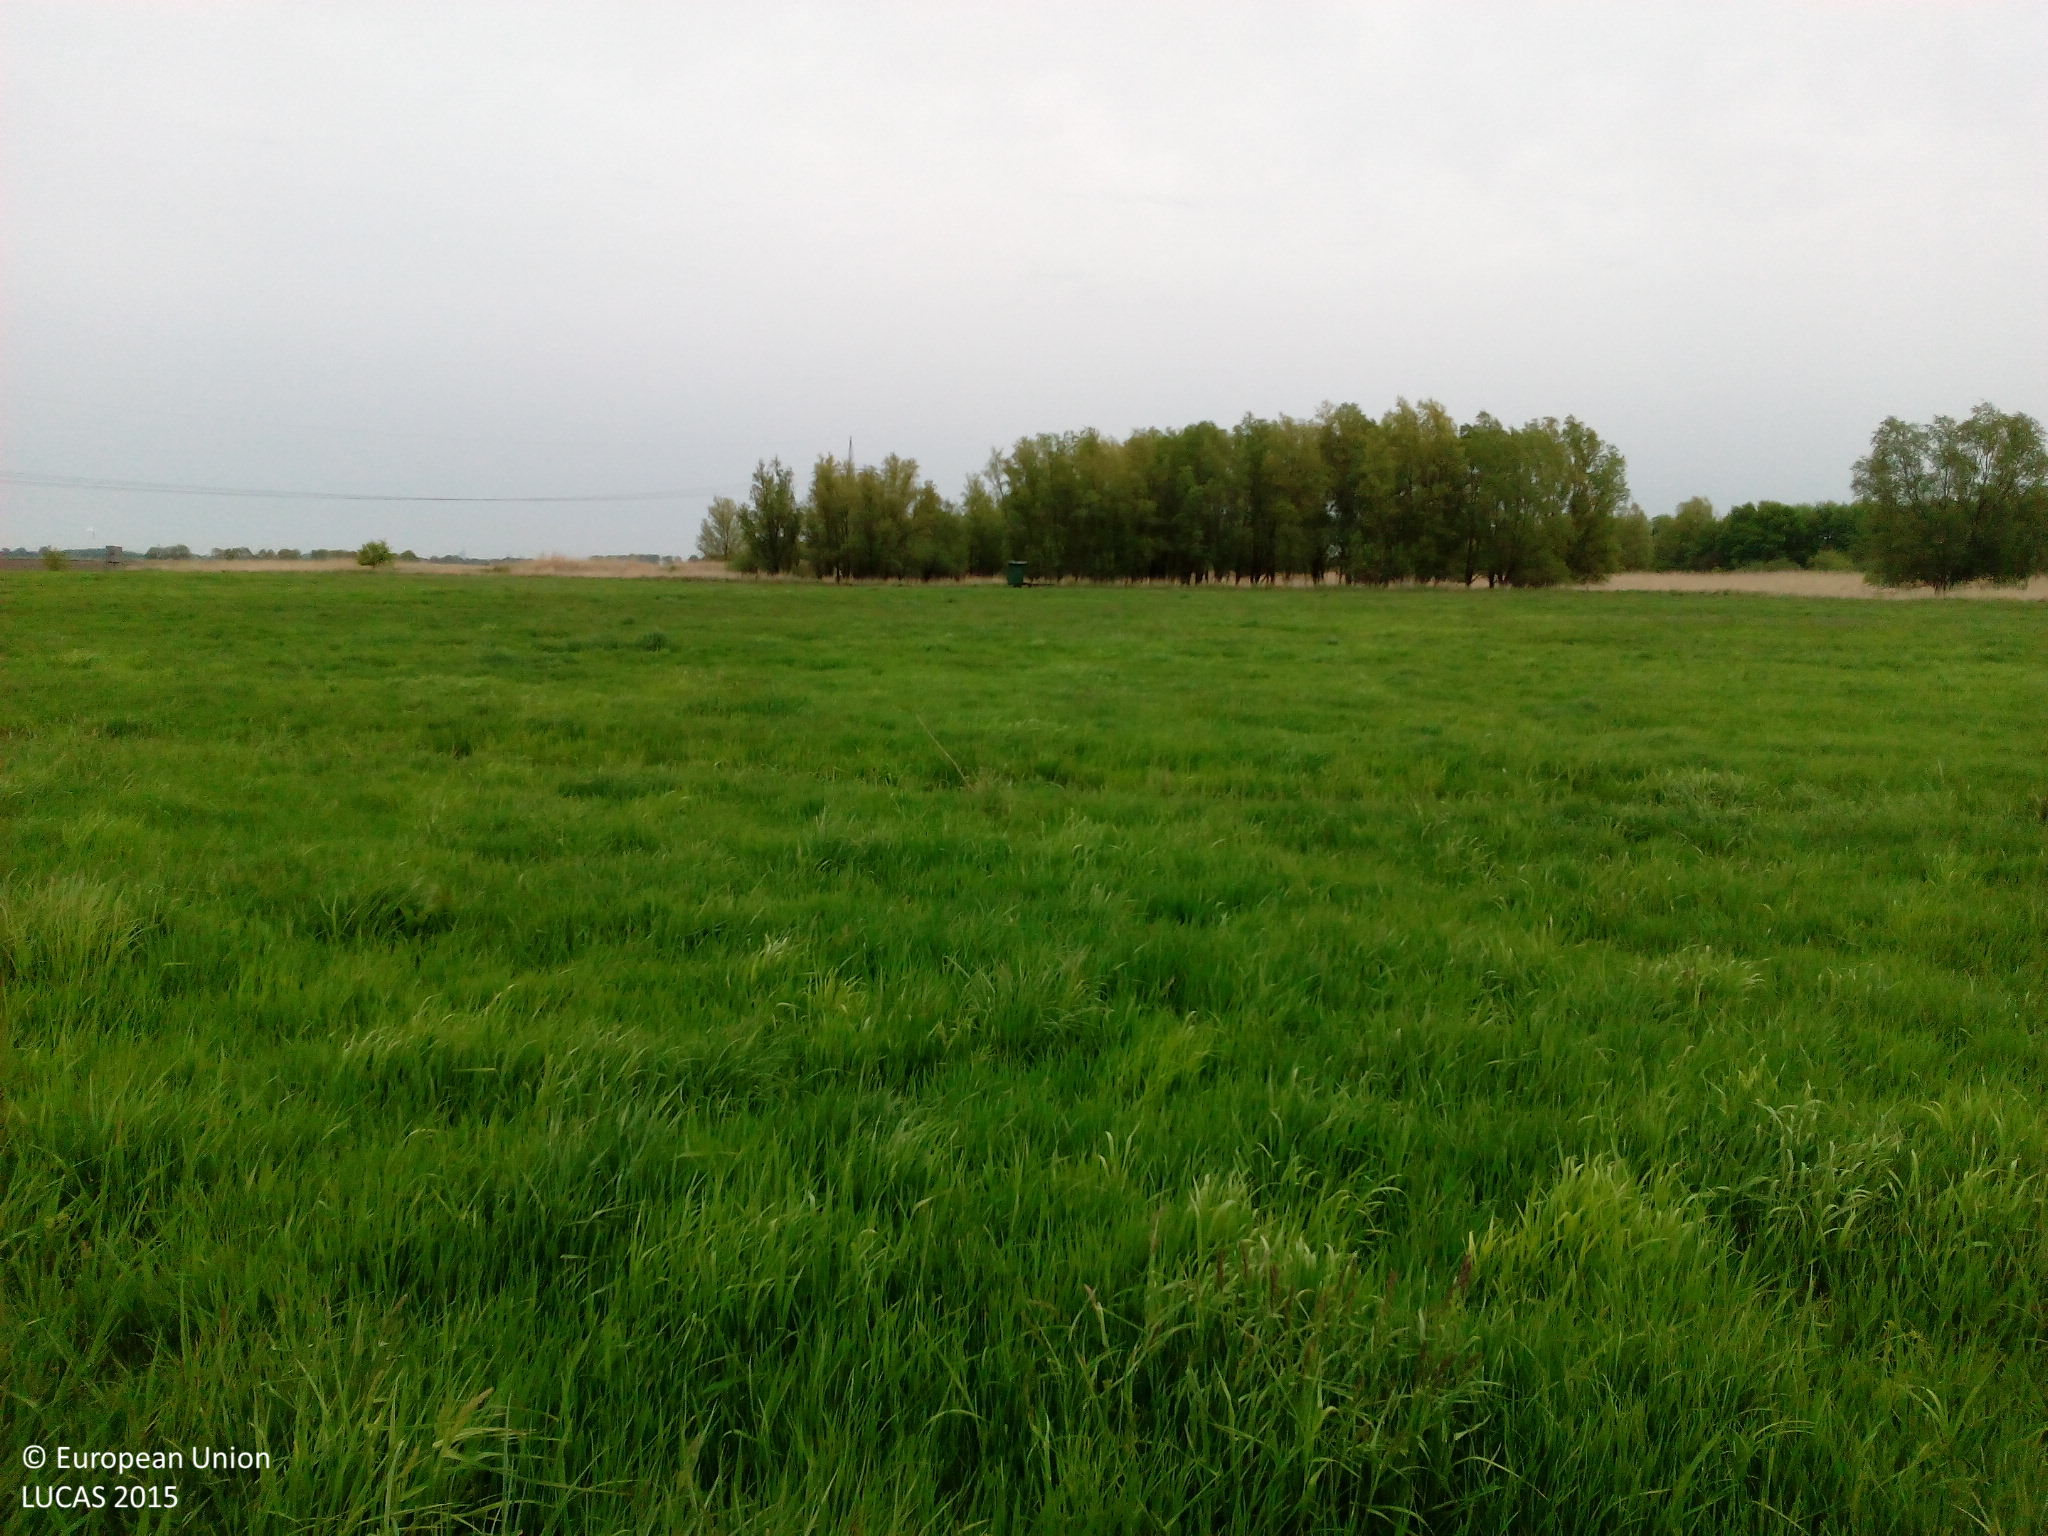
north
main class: Grassland
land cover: Grassland without tree/shrub cover
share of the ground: > 75 %
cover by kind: herbaceous plants 100 %
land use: Agriculture (excluding fallow land and kitchen gardens)
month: May
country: DE
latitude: 53.4474
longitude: 8.5702
